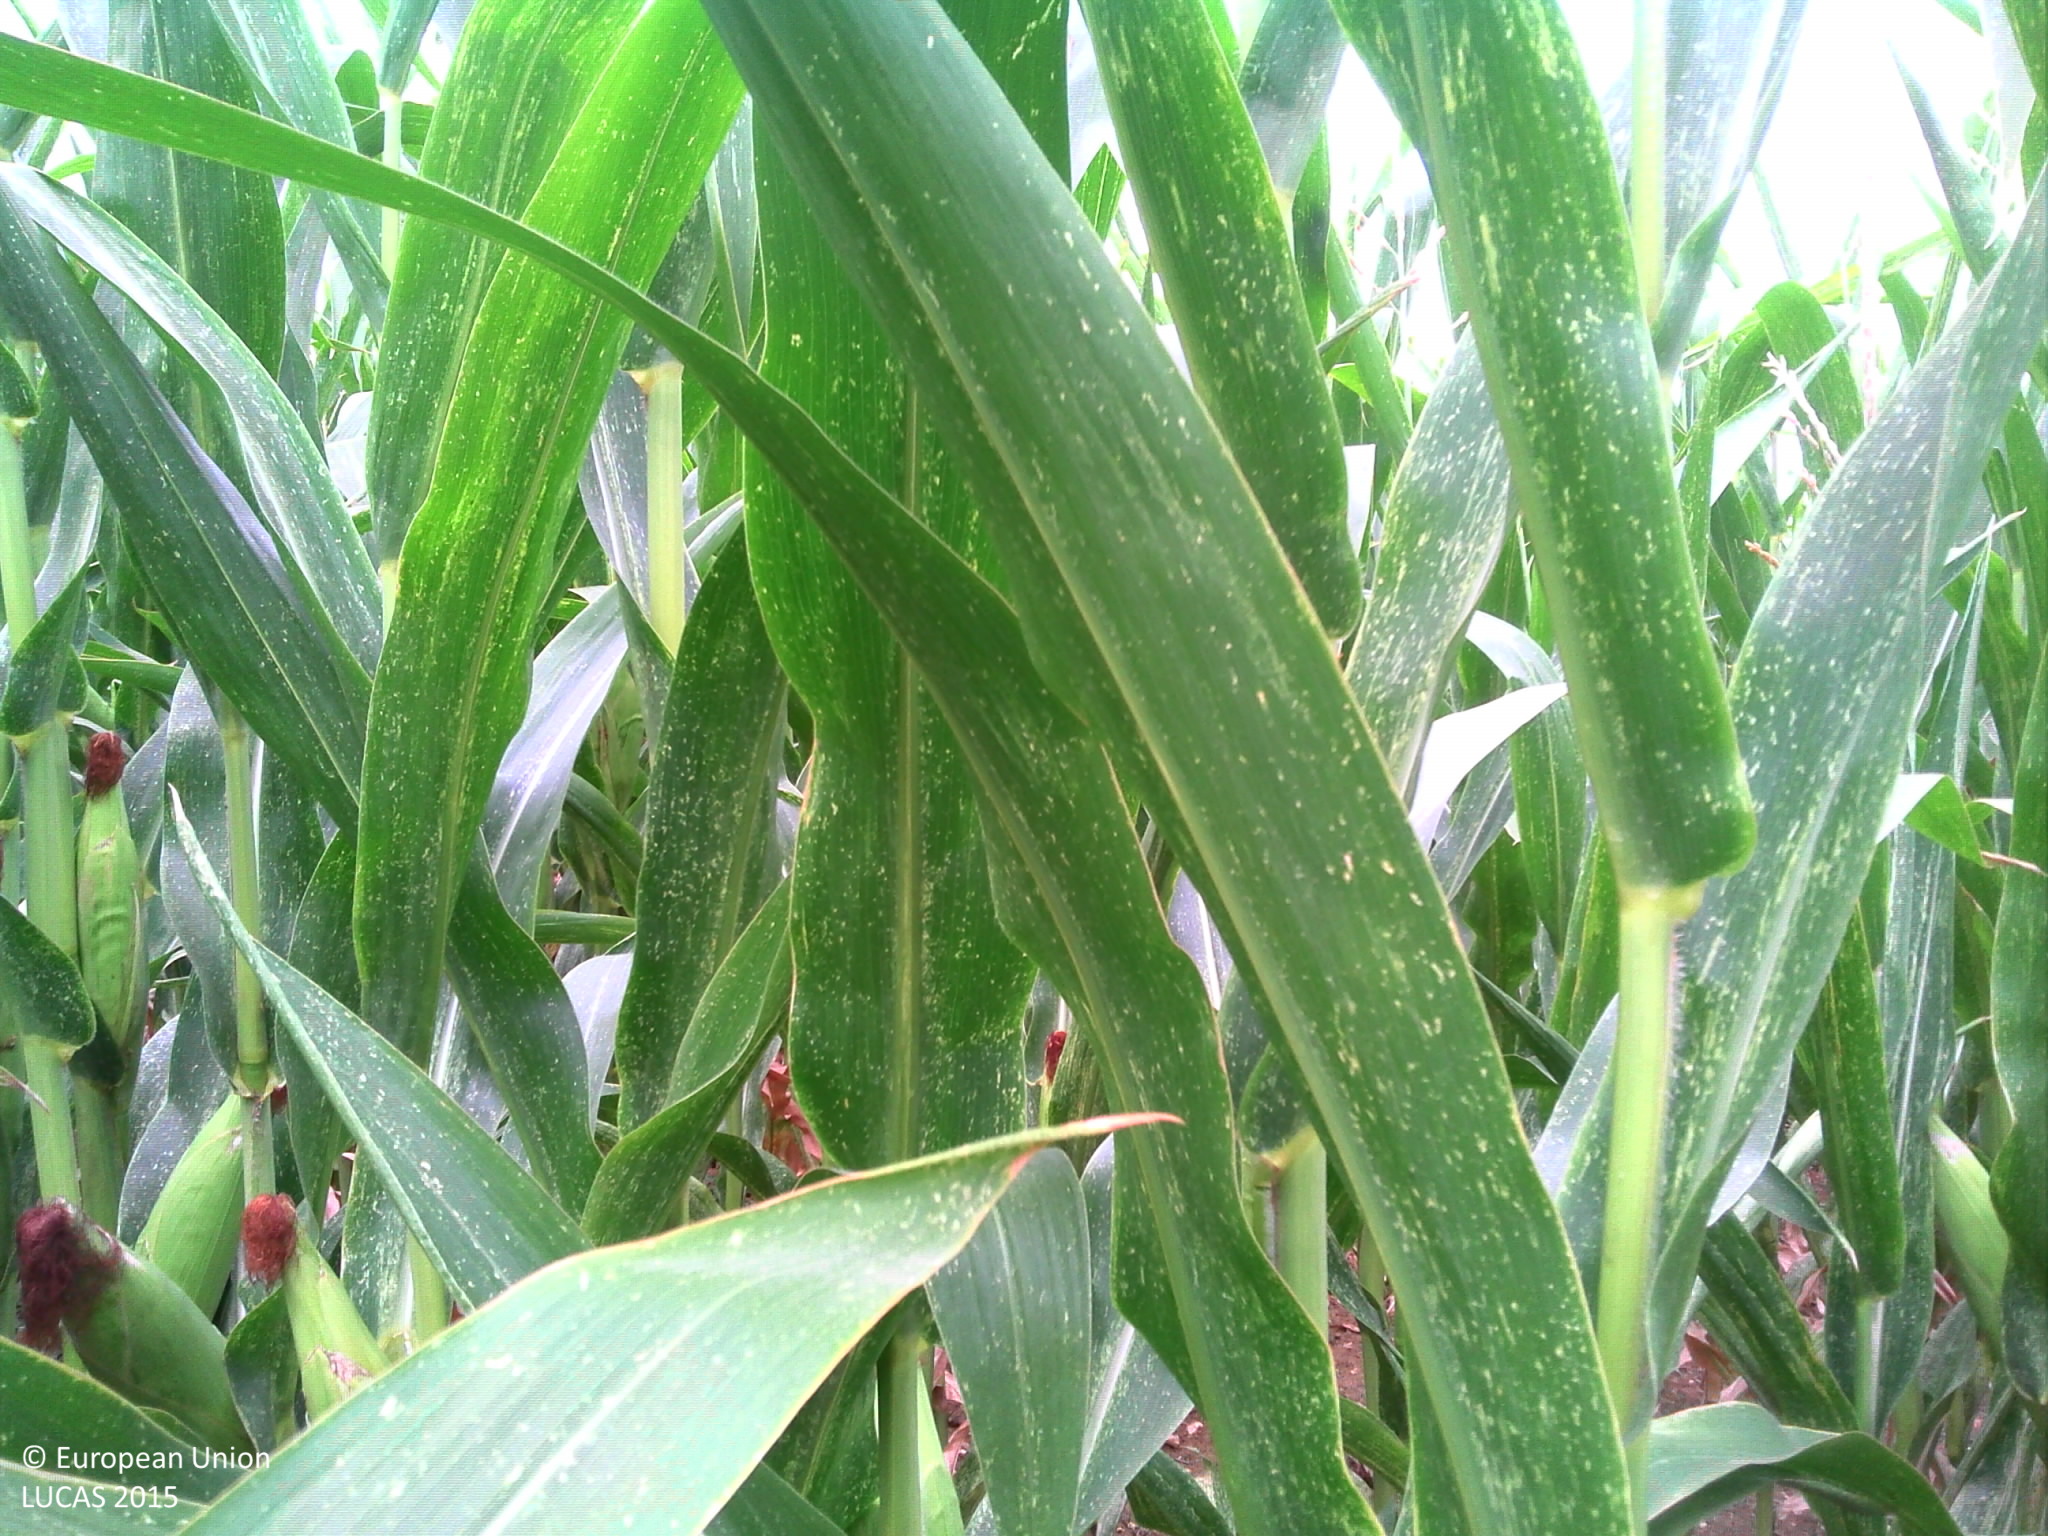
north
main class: Cropland
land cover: Maize
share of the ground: > 75 %
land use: Agriculture (excluding fallow land and kitchen gardens)
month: July
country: FR
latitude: 44.0878
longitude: 0.6158
